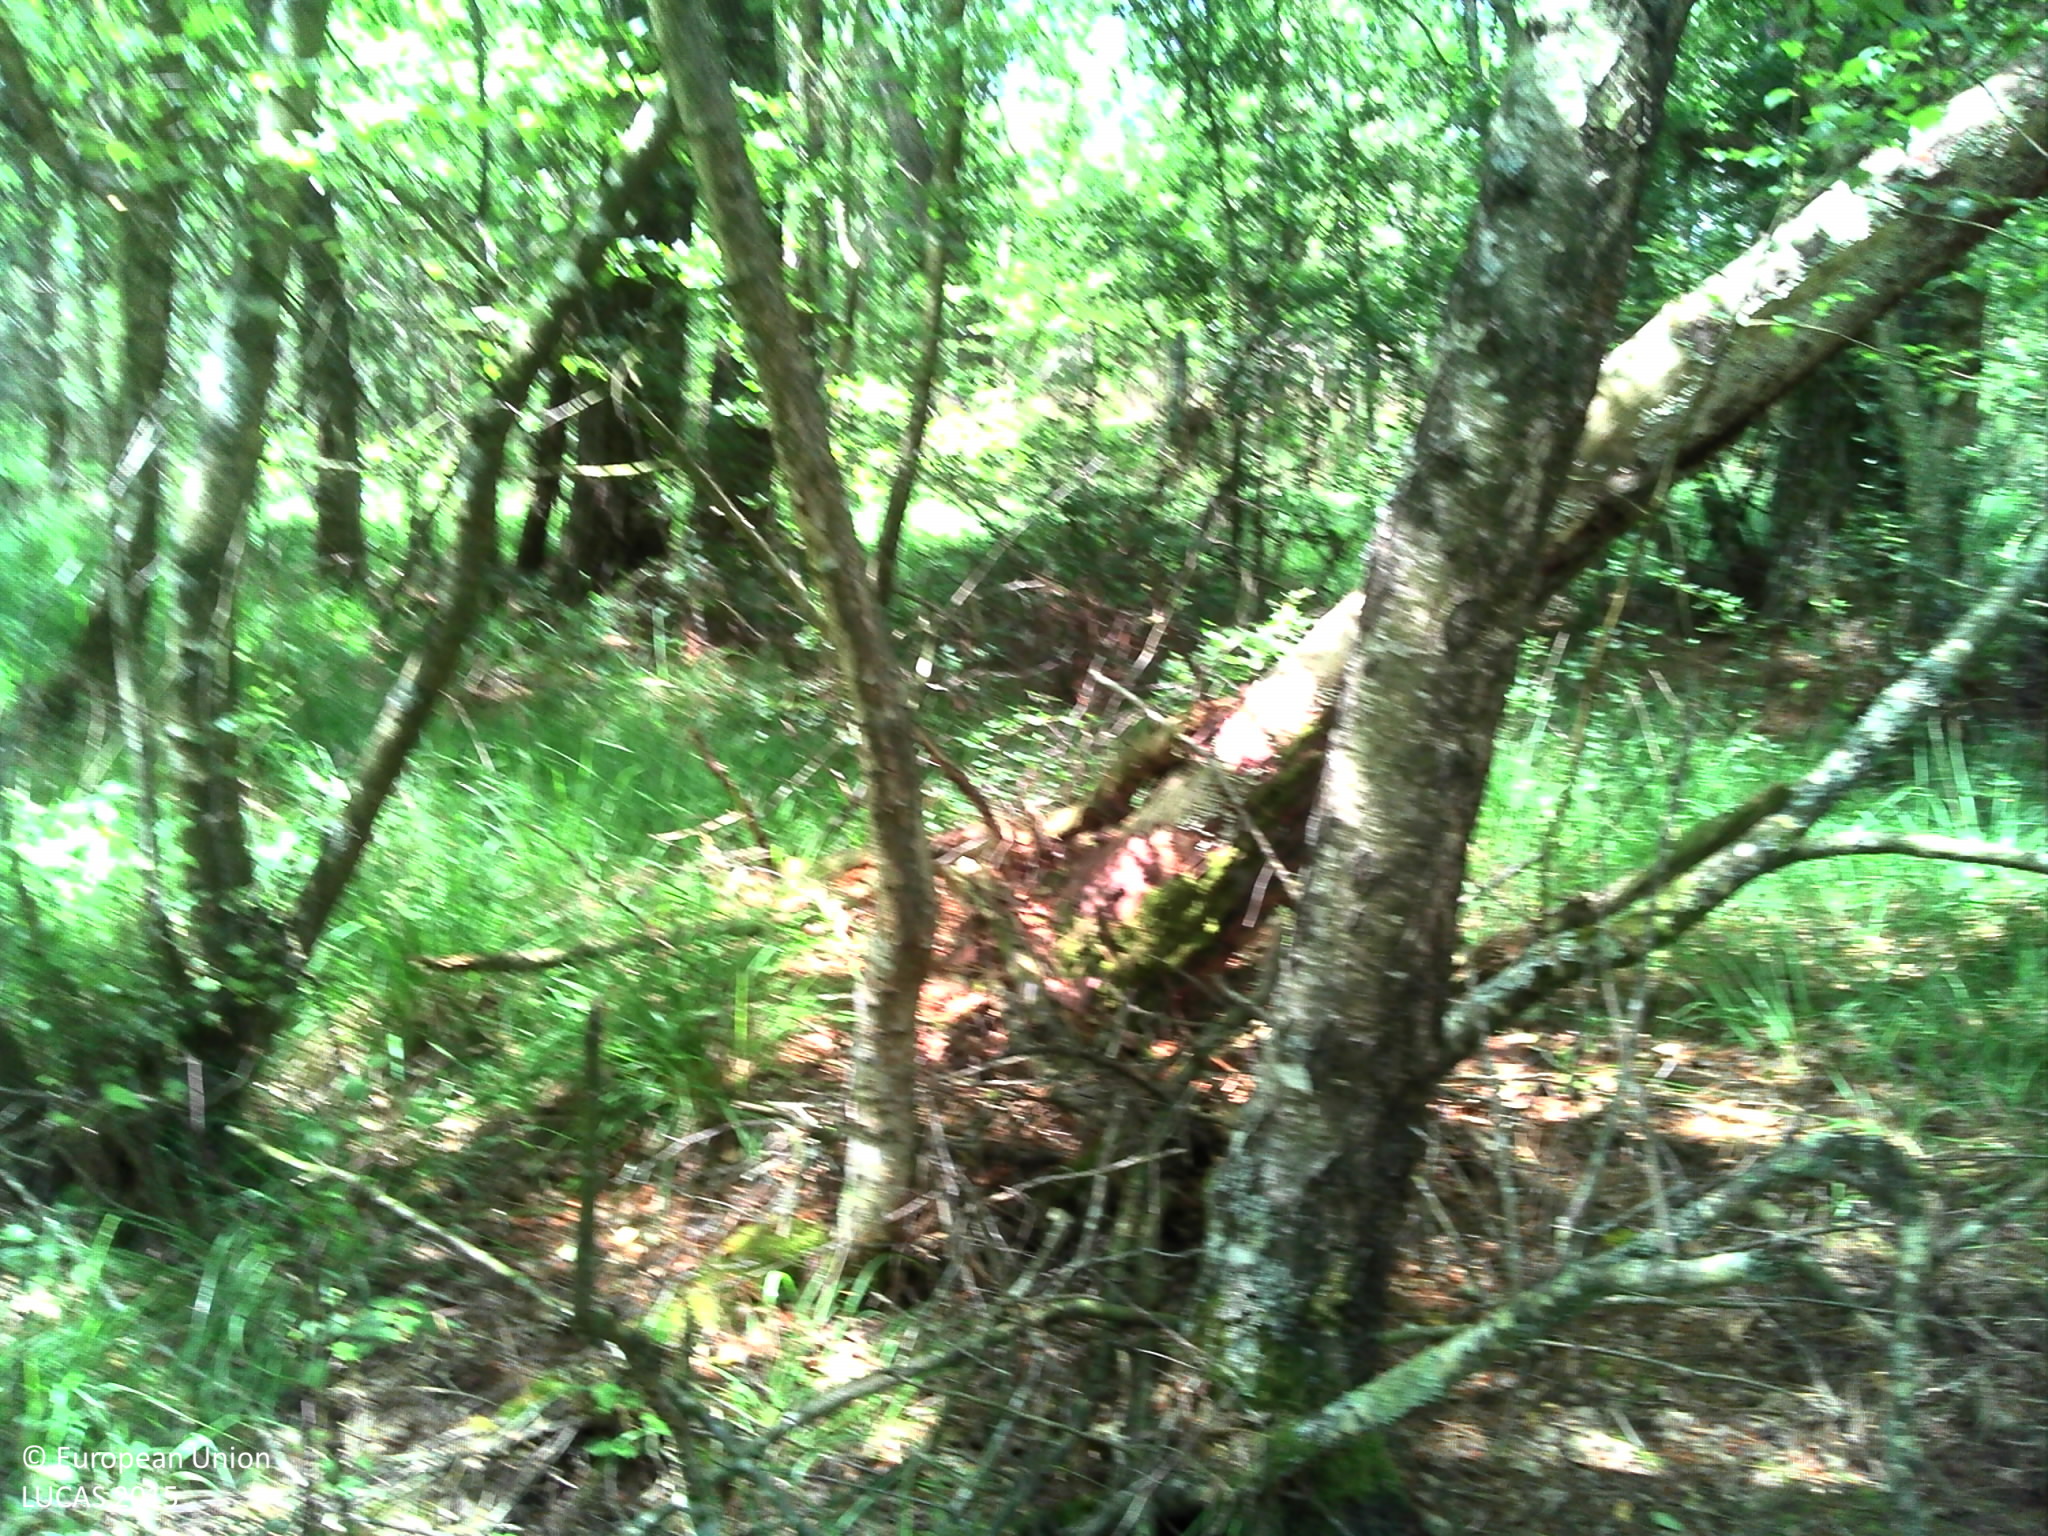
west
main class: Woodland
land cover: Broadleaved woodland
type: acidophilous oak and oak-birch forest
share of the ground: > 75 %
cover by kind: broadleaved forest trees 70 %, herbaceous plants 30 %
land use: Forestry
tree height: > 5 m
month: June
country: FR
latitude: 48.0676
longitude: -2.0642
